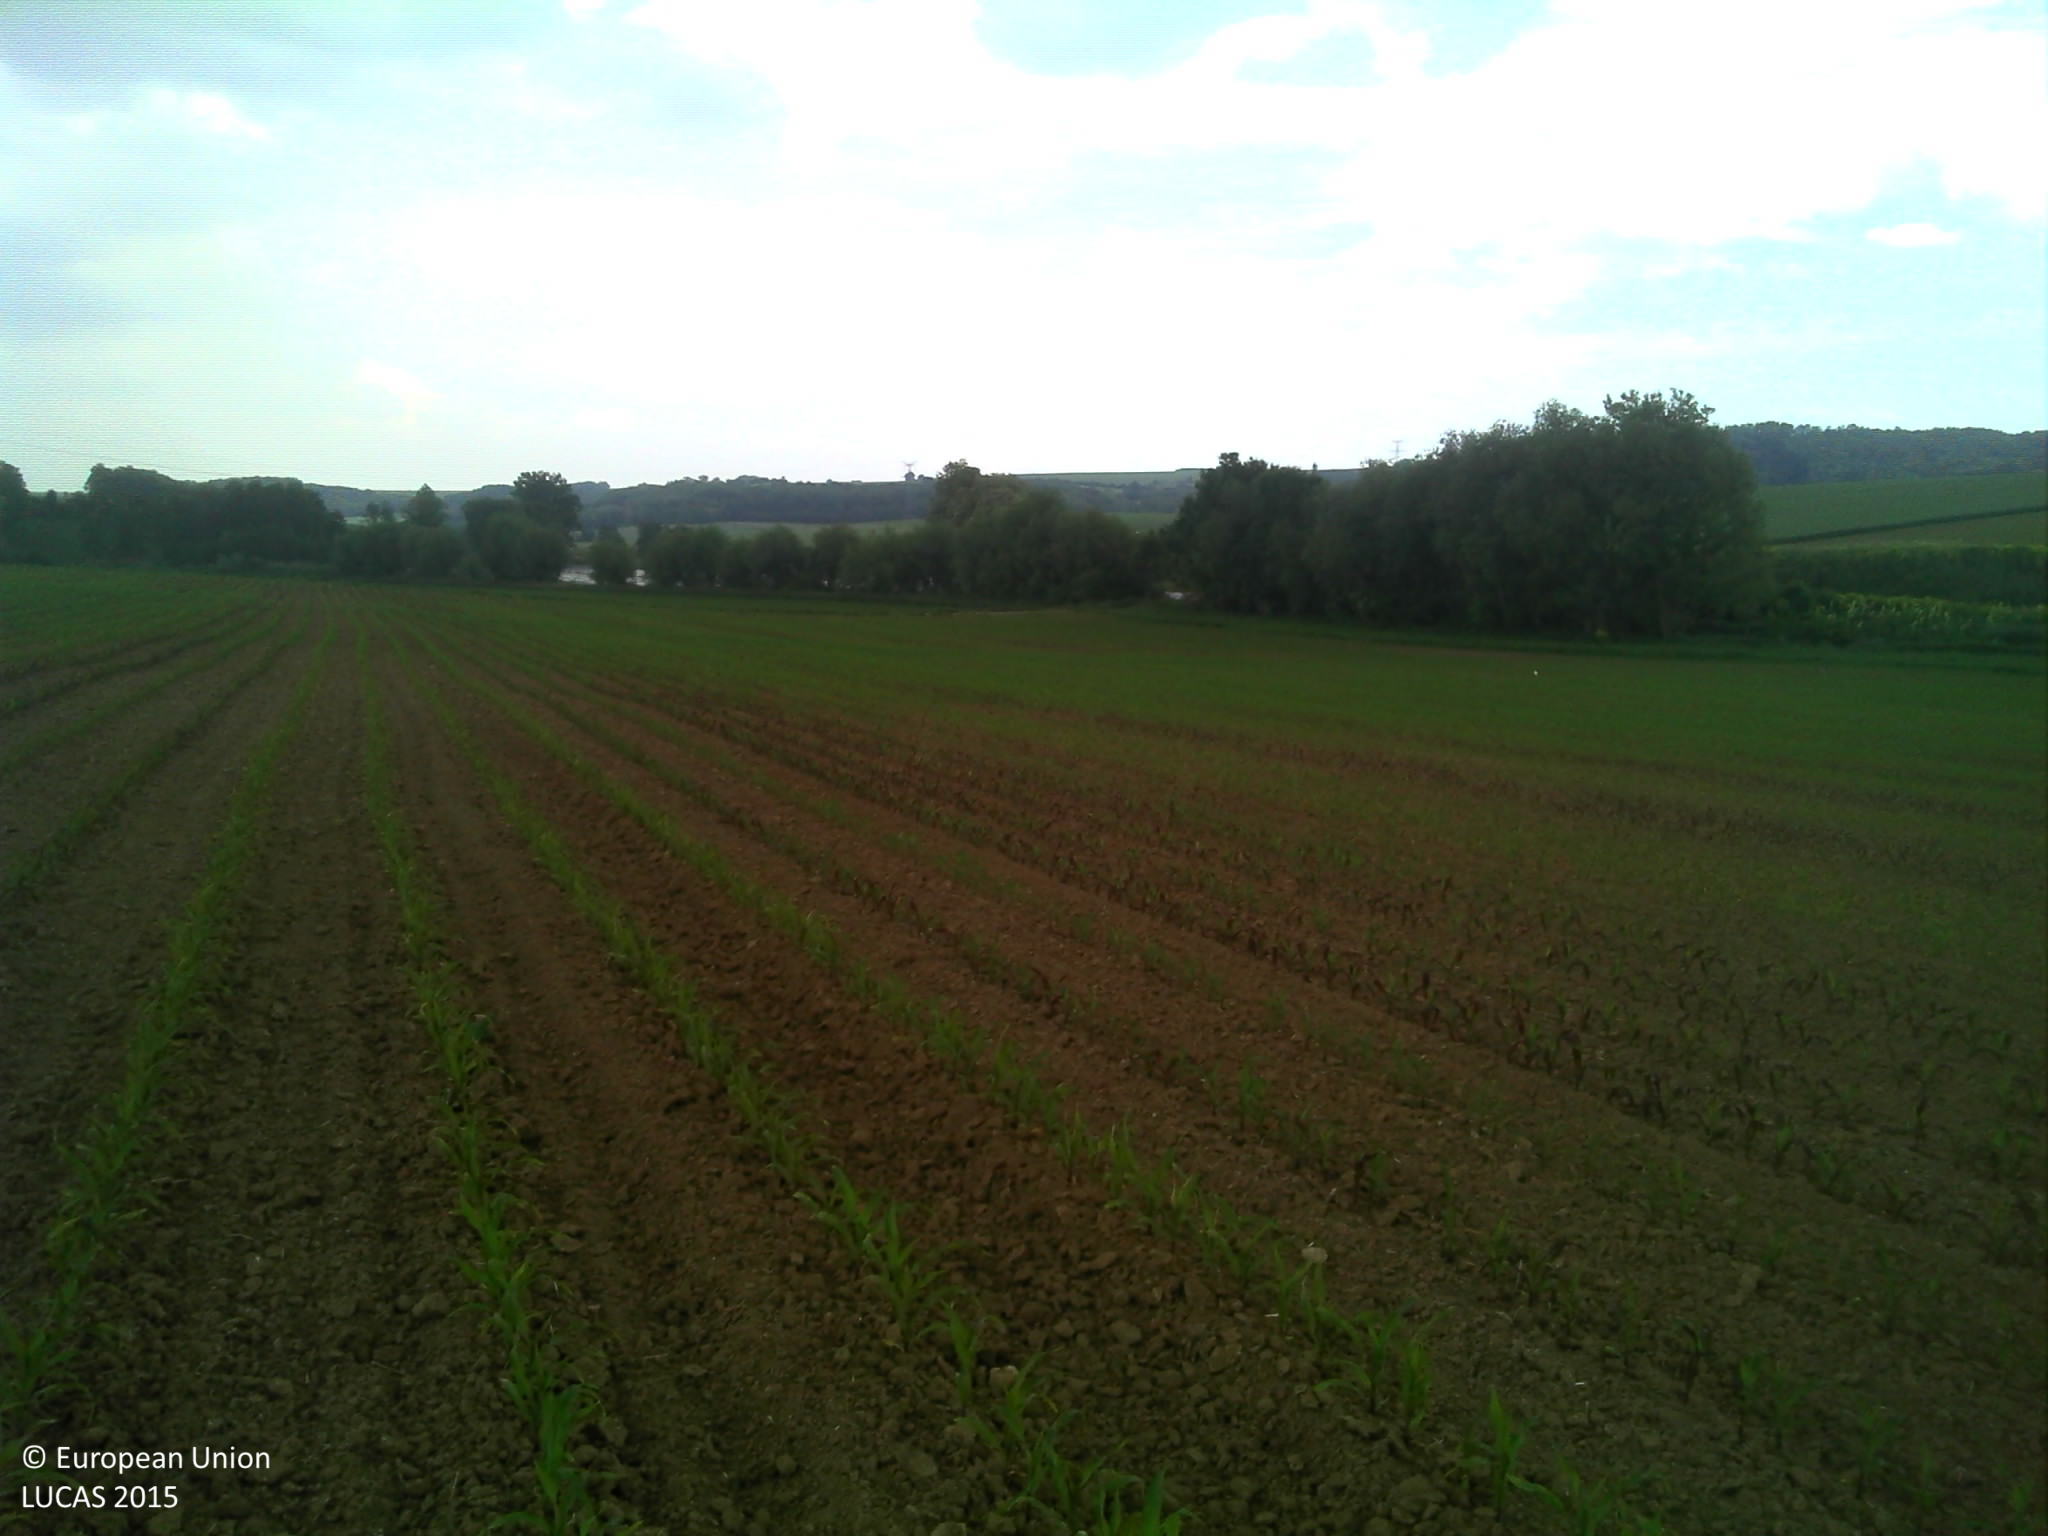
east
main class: Cropland
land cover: Maize
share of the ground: 10 - 25 %
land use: Agriculture (excluding fallow land and kitchen gardens)
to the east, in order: Maize; Grass margins; Tracks; Grass margins; Maize; Grassland without tree/shrub cover; Rivers and streams; Abandoned hedges; Other fresh vegetables
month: May
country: FR
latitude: 48.6816
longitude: 7.5152
